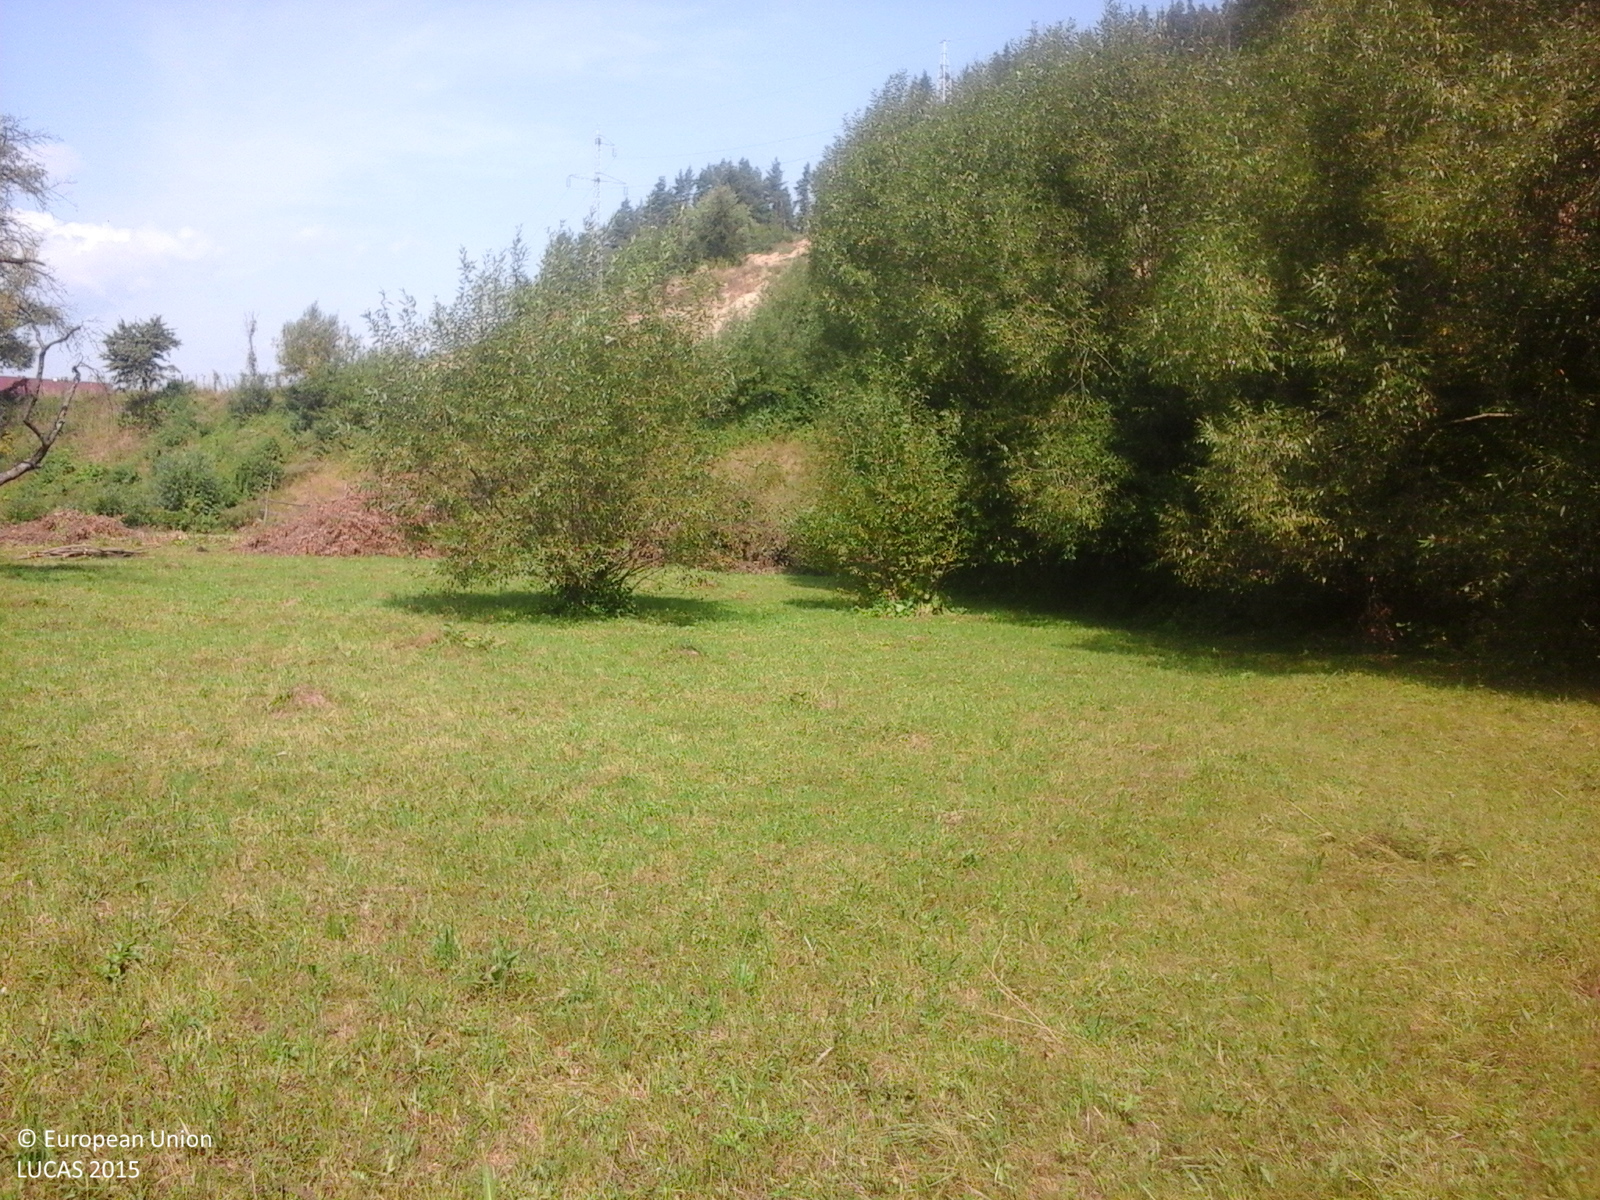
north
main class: Grassland
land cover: Grassland without tree/shrub cover
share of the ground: > 75 %
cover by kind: herbaceous plants 100 %
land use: Agriculture (excluding fallow land and kitchen gardens)
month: September
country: RO
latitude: 47.7814
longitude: 24.2779
